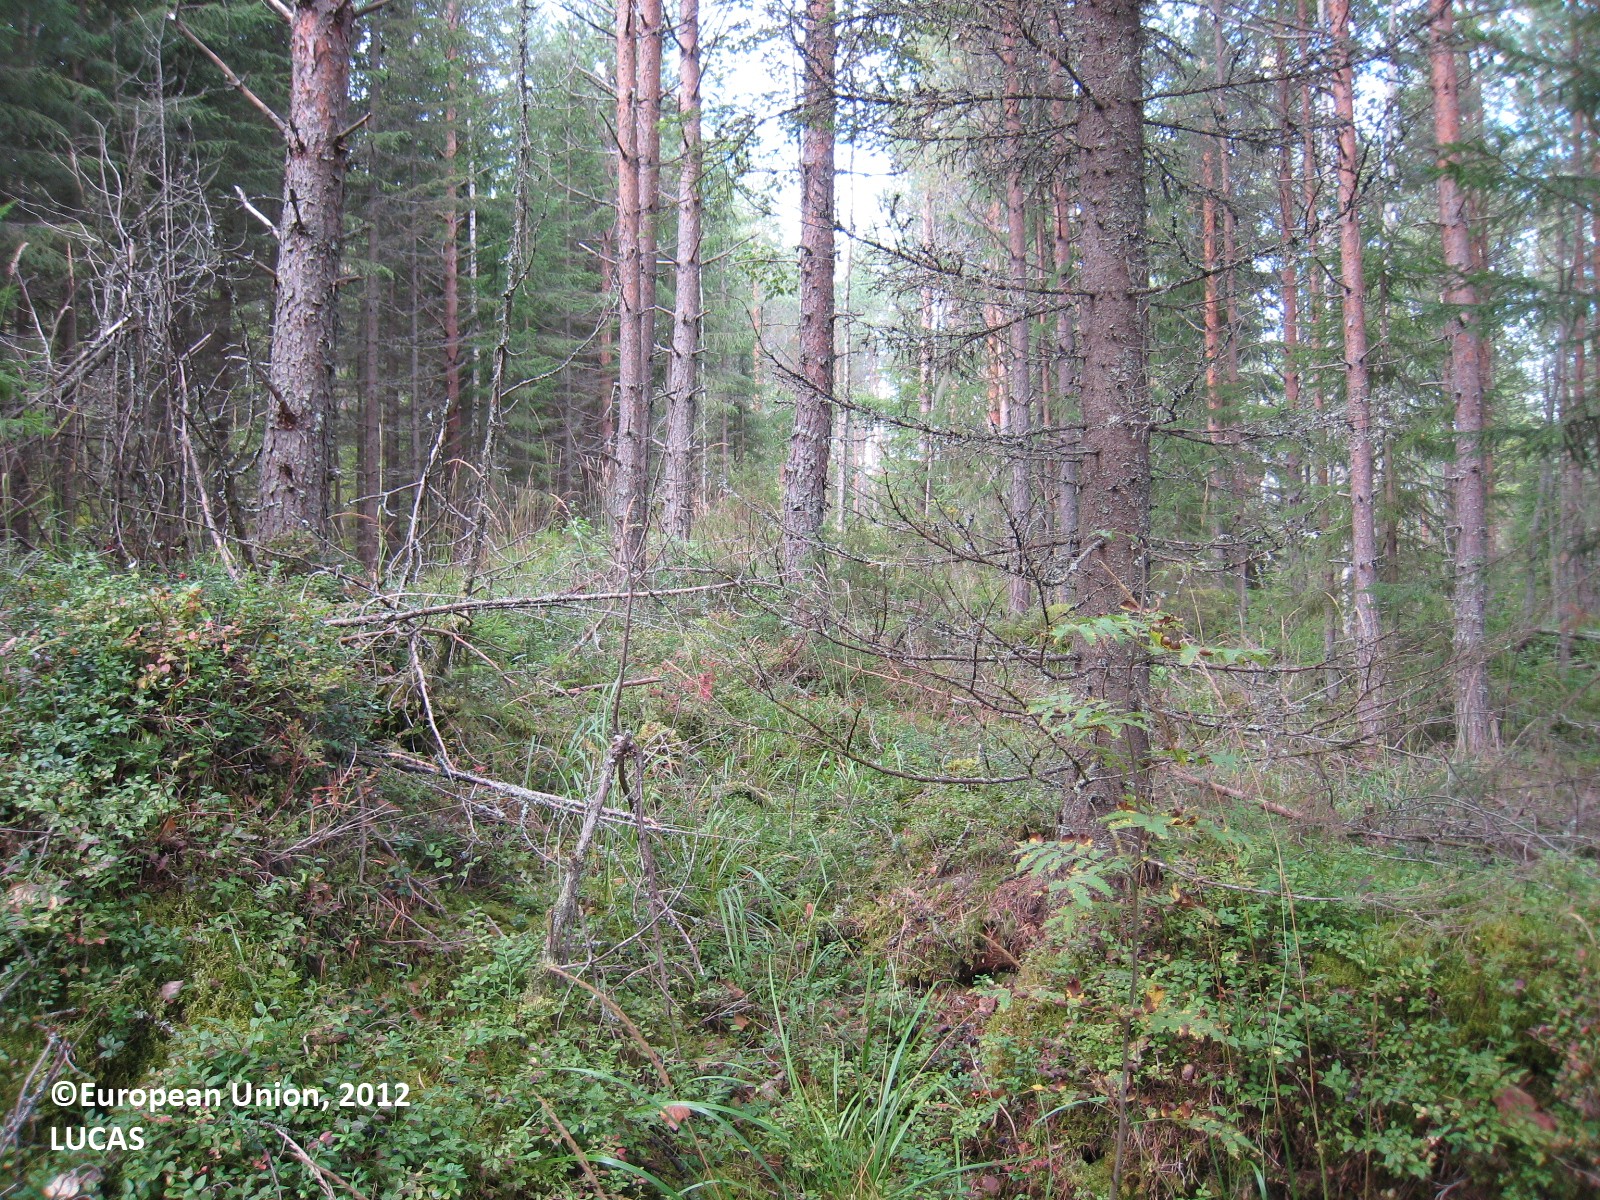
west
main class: Woodland
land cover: Pine dominated coniferous woodland
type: boreal forest
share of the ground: > 75 %
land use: Forestry
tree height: > 5 m
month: August
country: FI
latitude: 62.1372
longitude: 27.2924
